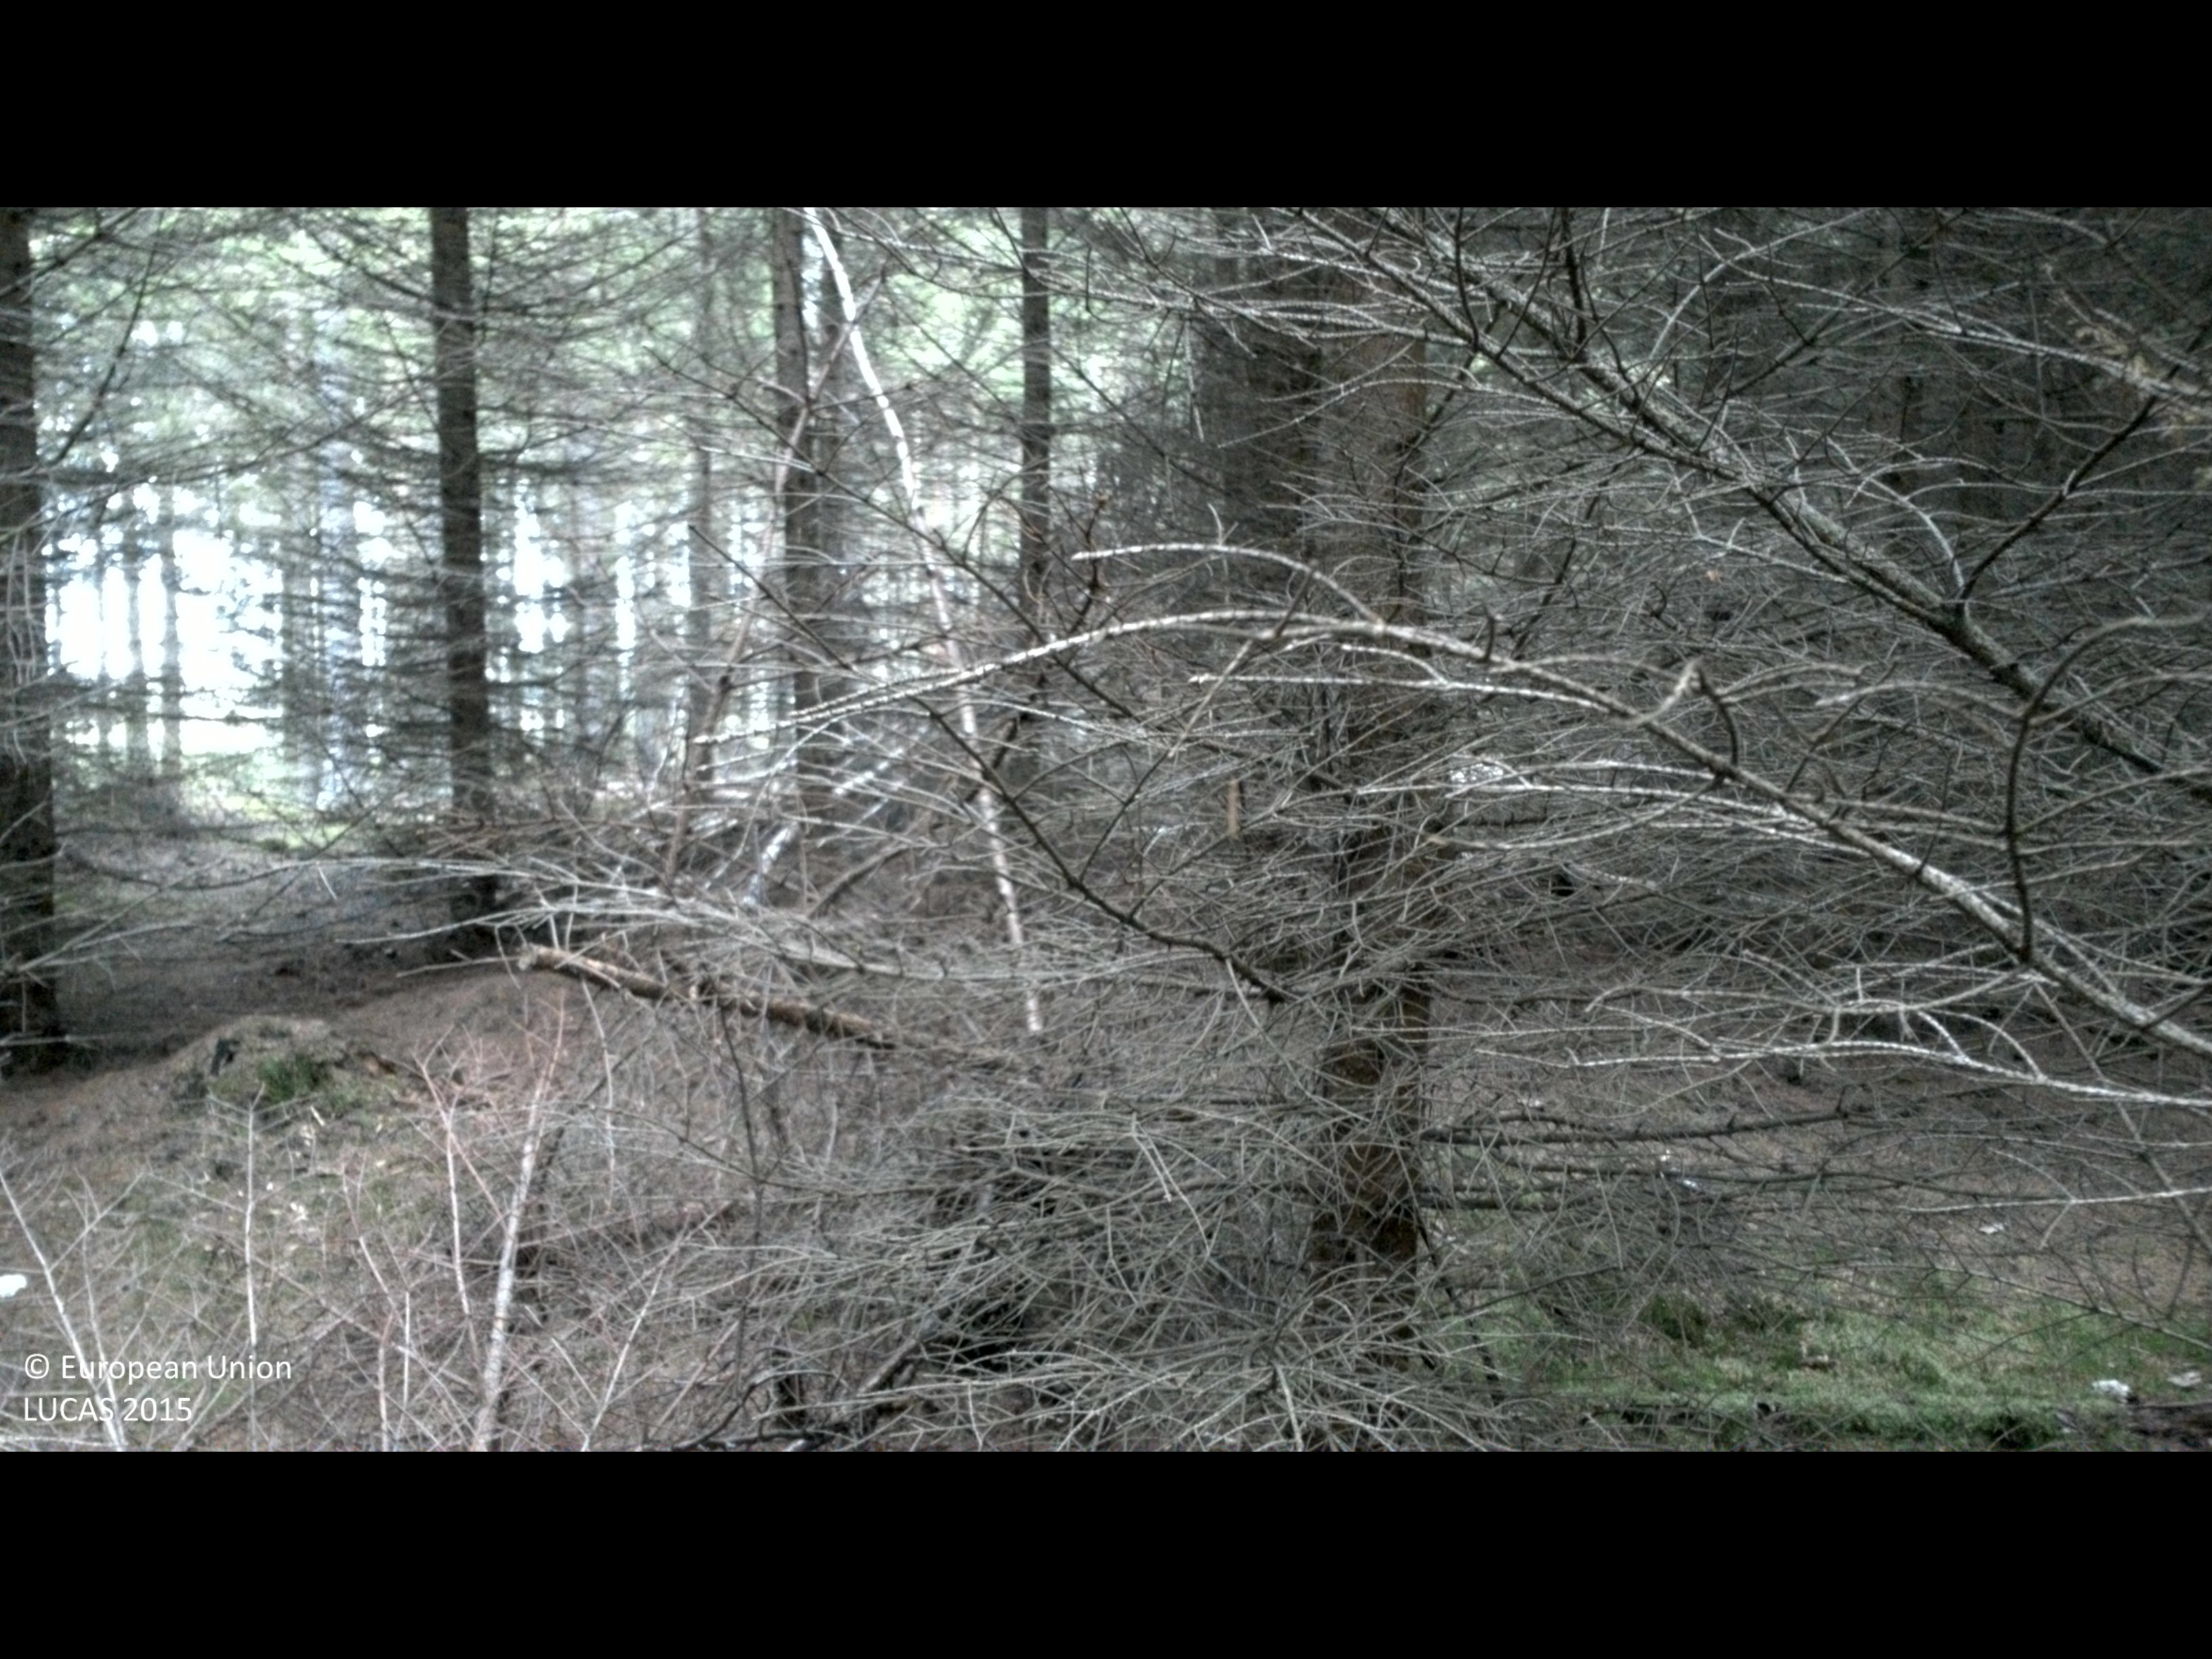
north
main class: Woodland
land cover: Spruce dominated coniferous woodland
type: boreal forest
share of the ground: > 75 %
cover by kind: coniferous forest trees 90 %, lichens and mosses 5 %
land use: Forestry
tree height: > 5 m
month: September
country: SE
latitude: 56.1372
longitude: 14.1978
